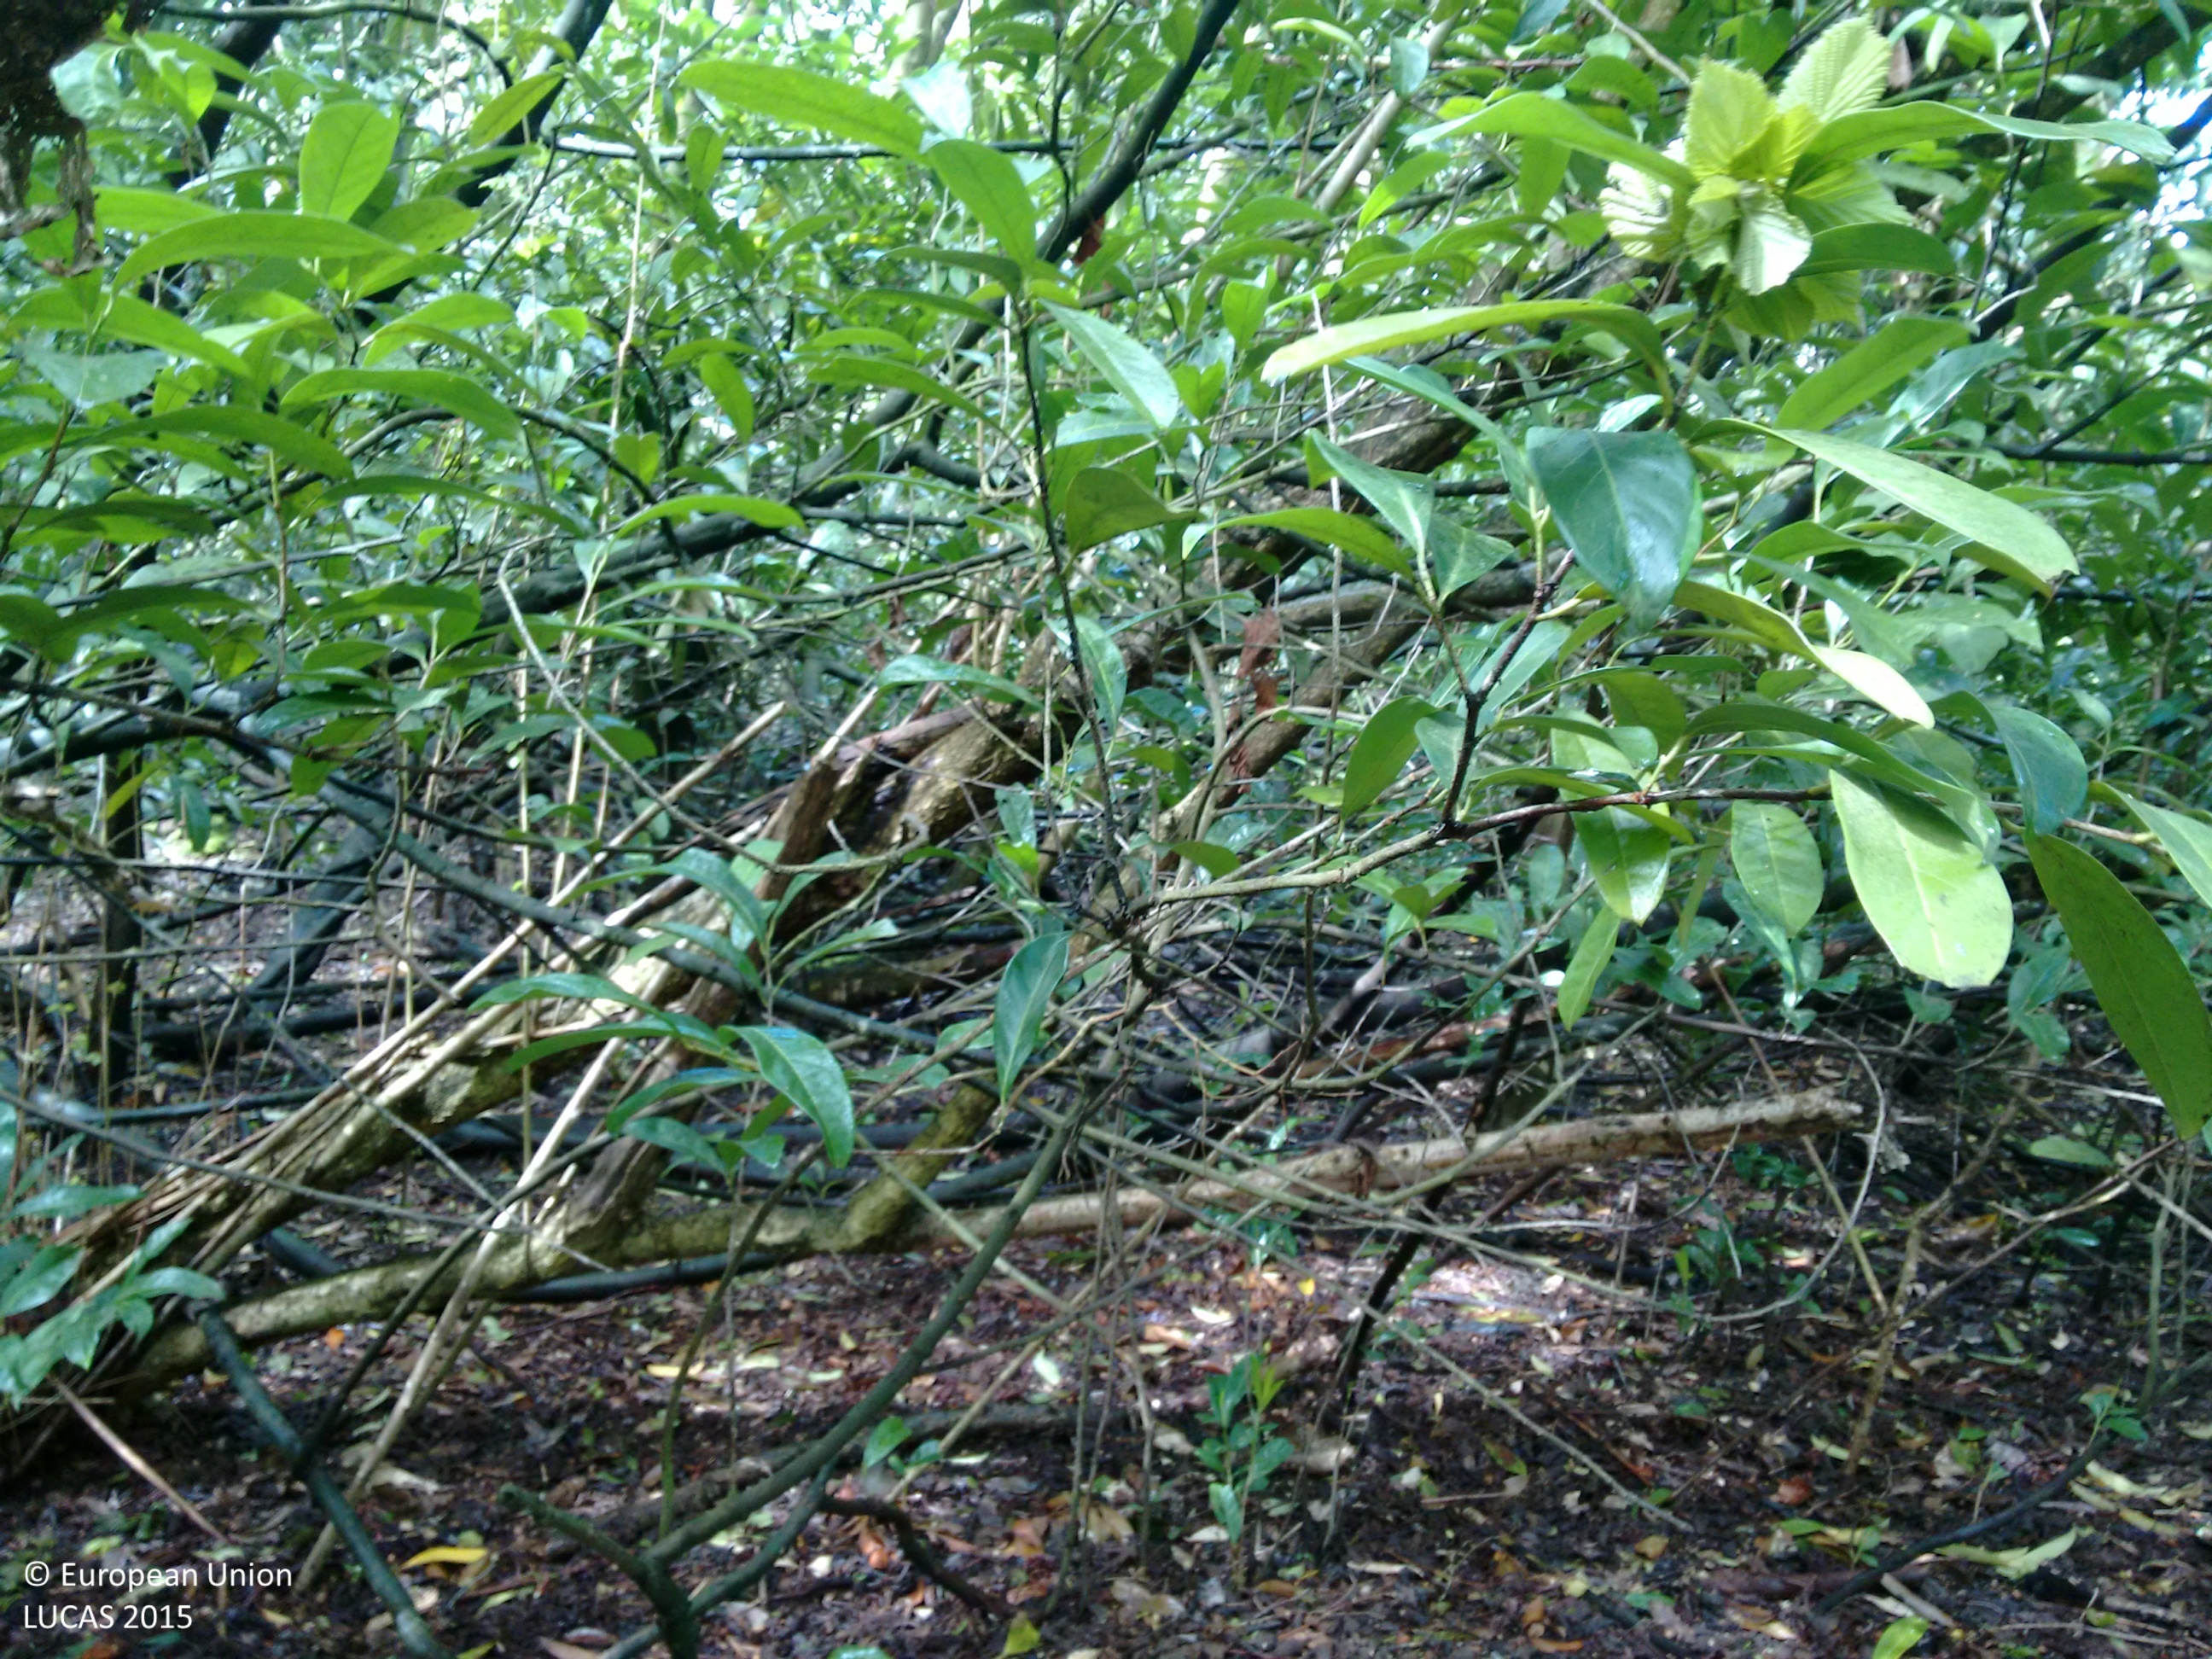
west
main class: Woodland
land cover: Broadleaved woodland
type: mesophytic deciduous forest
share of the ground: > 75 %
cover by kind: broadleaved forest trees 100 %
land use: Forestry
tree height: > 5 m
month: May
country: GB
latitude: 51.3115
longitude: 0.1124
